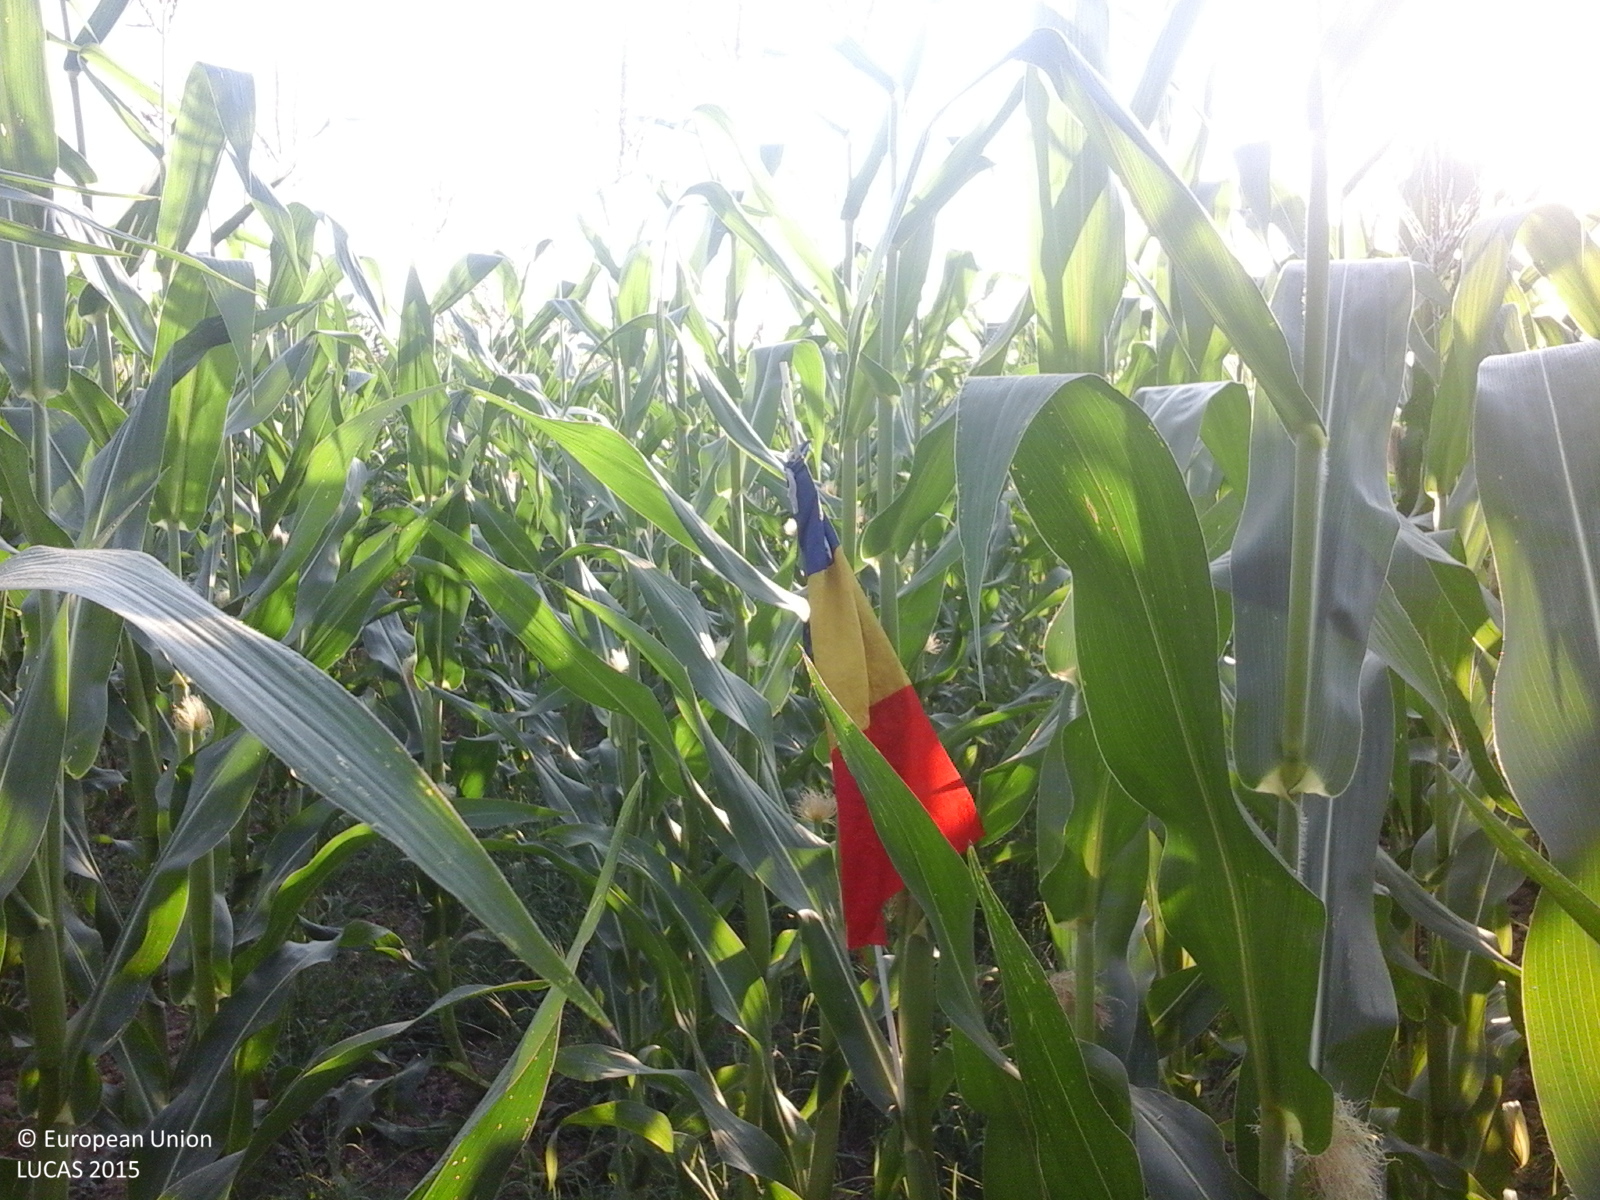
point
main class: Cropland
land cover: Maize
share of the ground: > 75 %
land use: Agriculture (excluding fallow land and kitchen gardens)
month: July
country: RO
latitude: 44.5785
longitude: 25.5721
